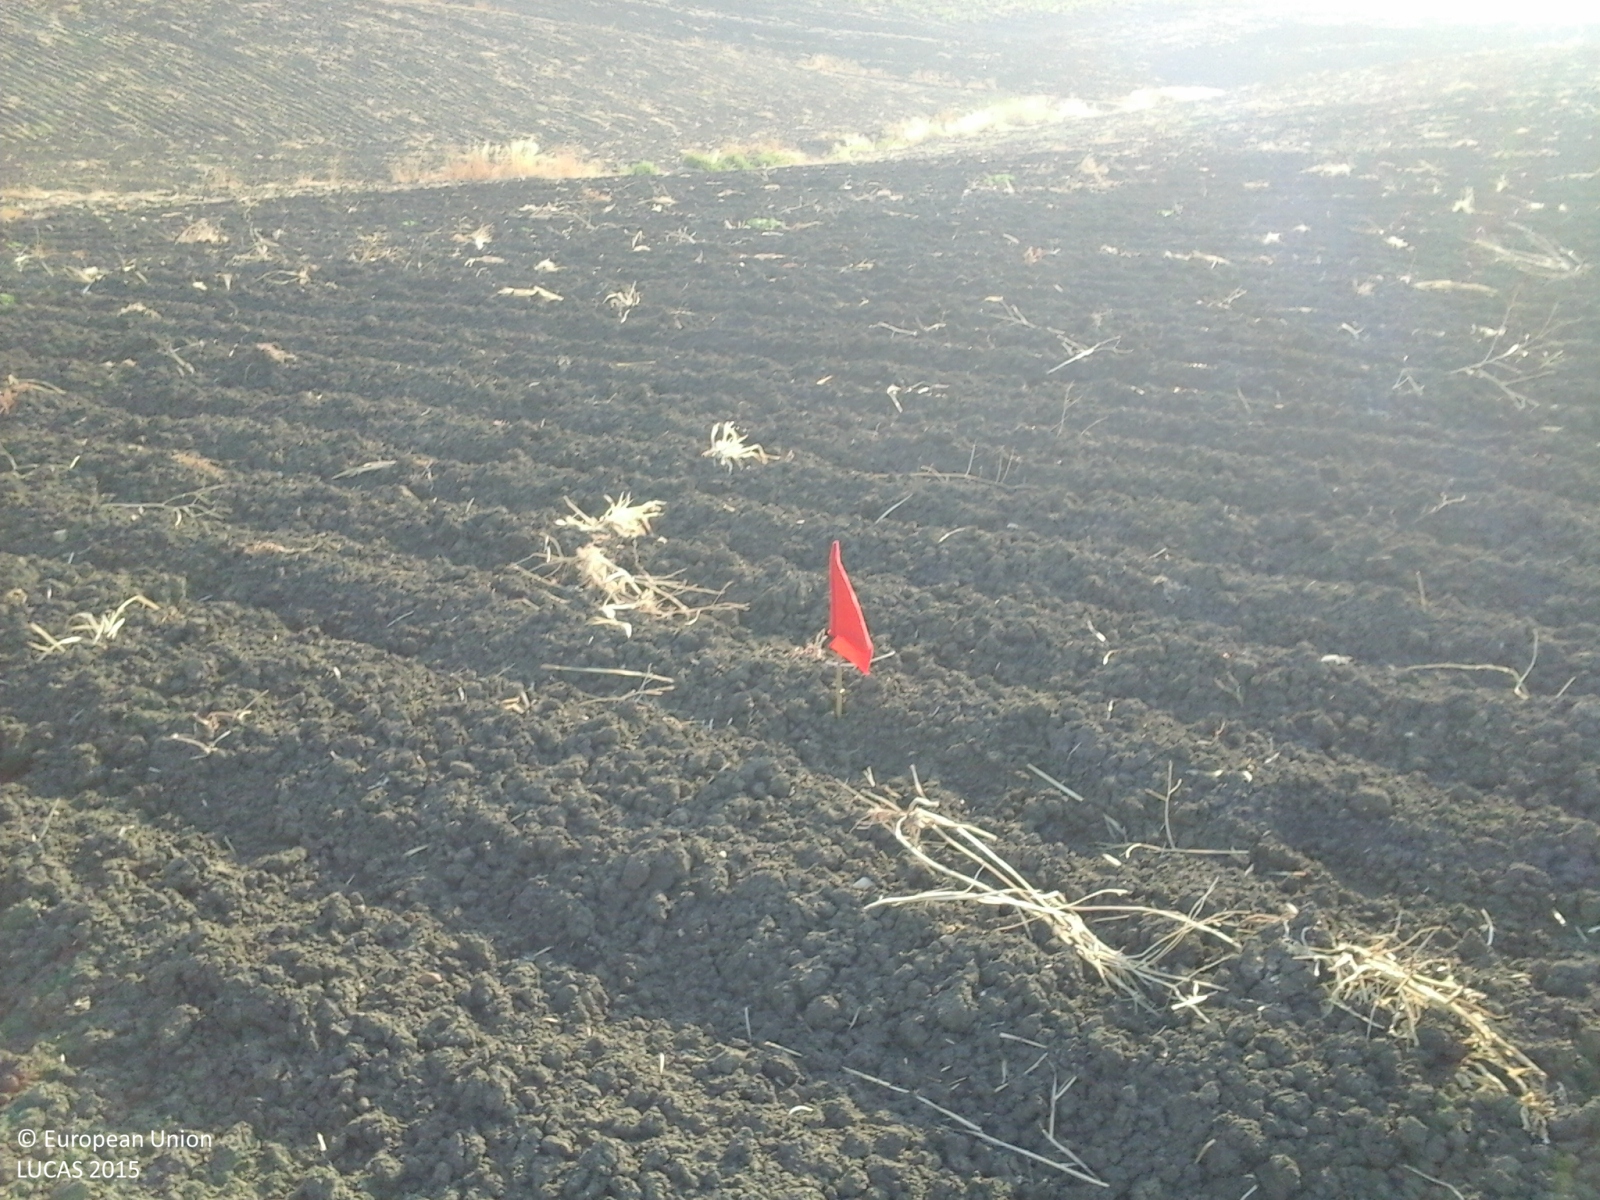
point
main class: Cropland
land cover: Durum wheat
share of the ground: > 75 %
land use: Agriculture (excluding fallow land and kitchen gardens)
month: July
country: IT
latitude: 37.2236
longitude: 14.0818
